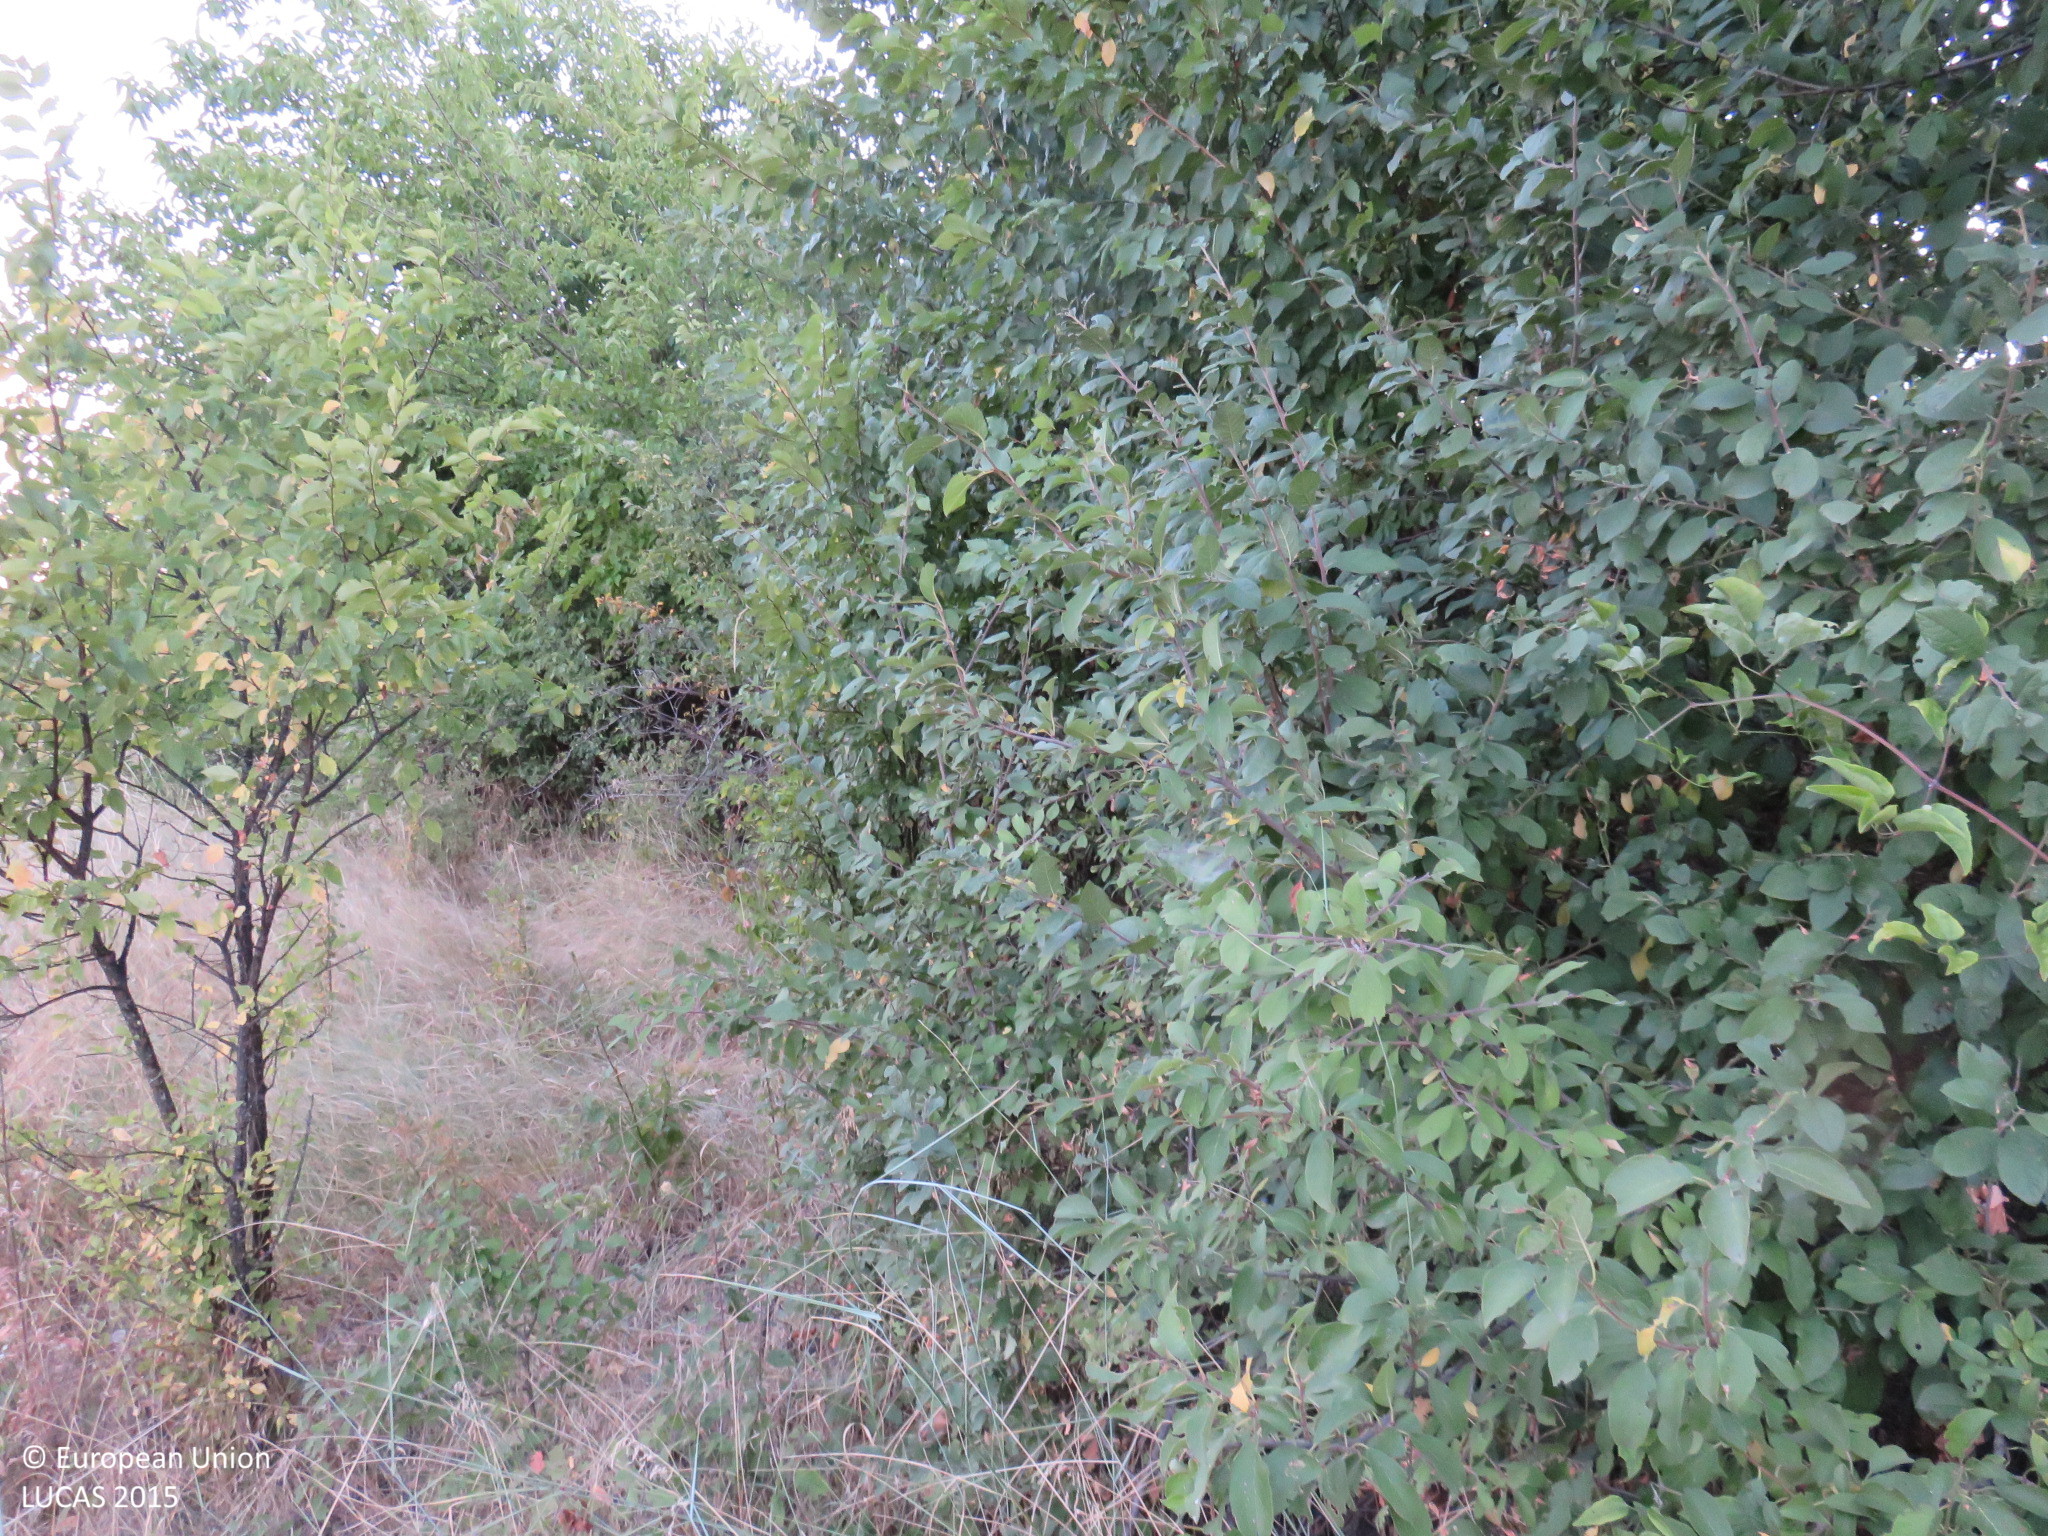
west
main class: Woodland
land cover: Broadleaved woodland
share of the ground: > 75 %
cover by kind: broadleaved forest trees 50 %, shrubs 50 %
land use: Semi-natural and natural areas not in use
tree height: > 5 m
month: July
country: BG
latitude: 43.1873
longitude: 25.1936
